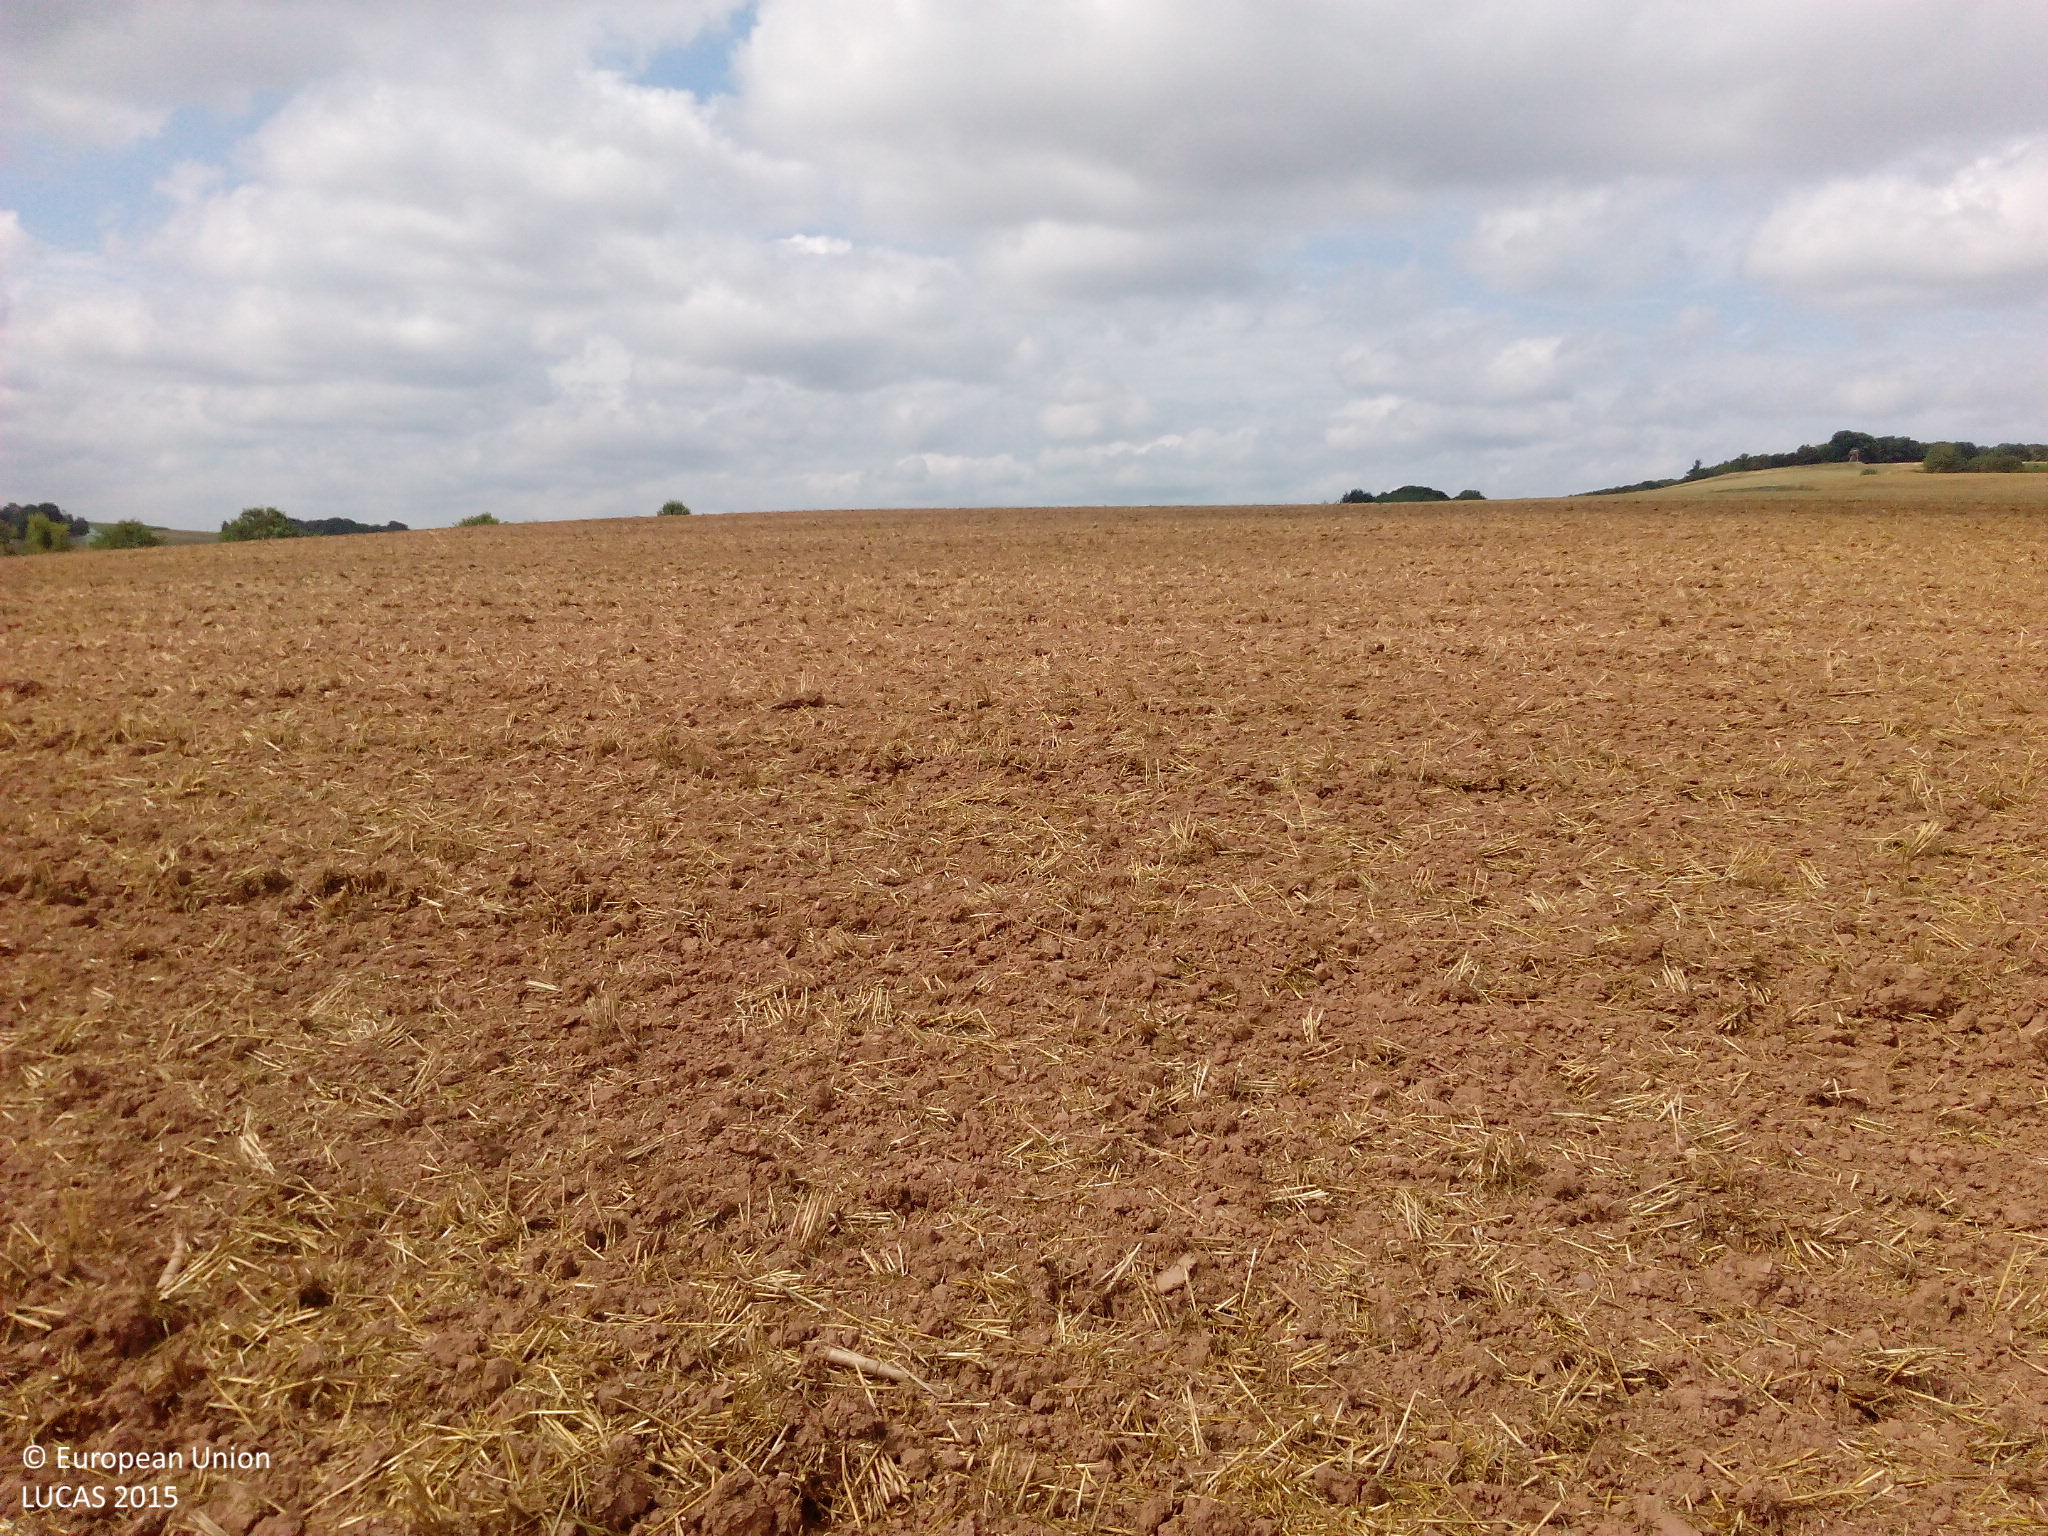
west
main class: Cropland
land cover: Common wheat
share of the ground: < 10 %
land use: Agriculture (excluding fallow land and kitchen gardens)
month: August
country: DE
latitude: 49.7440
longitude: 7.5441
